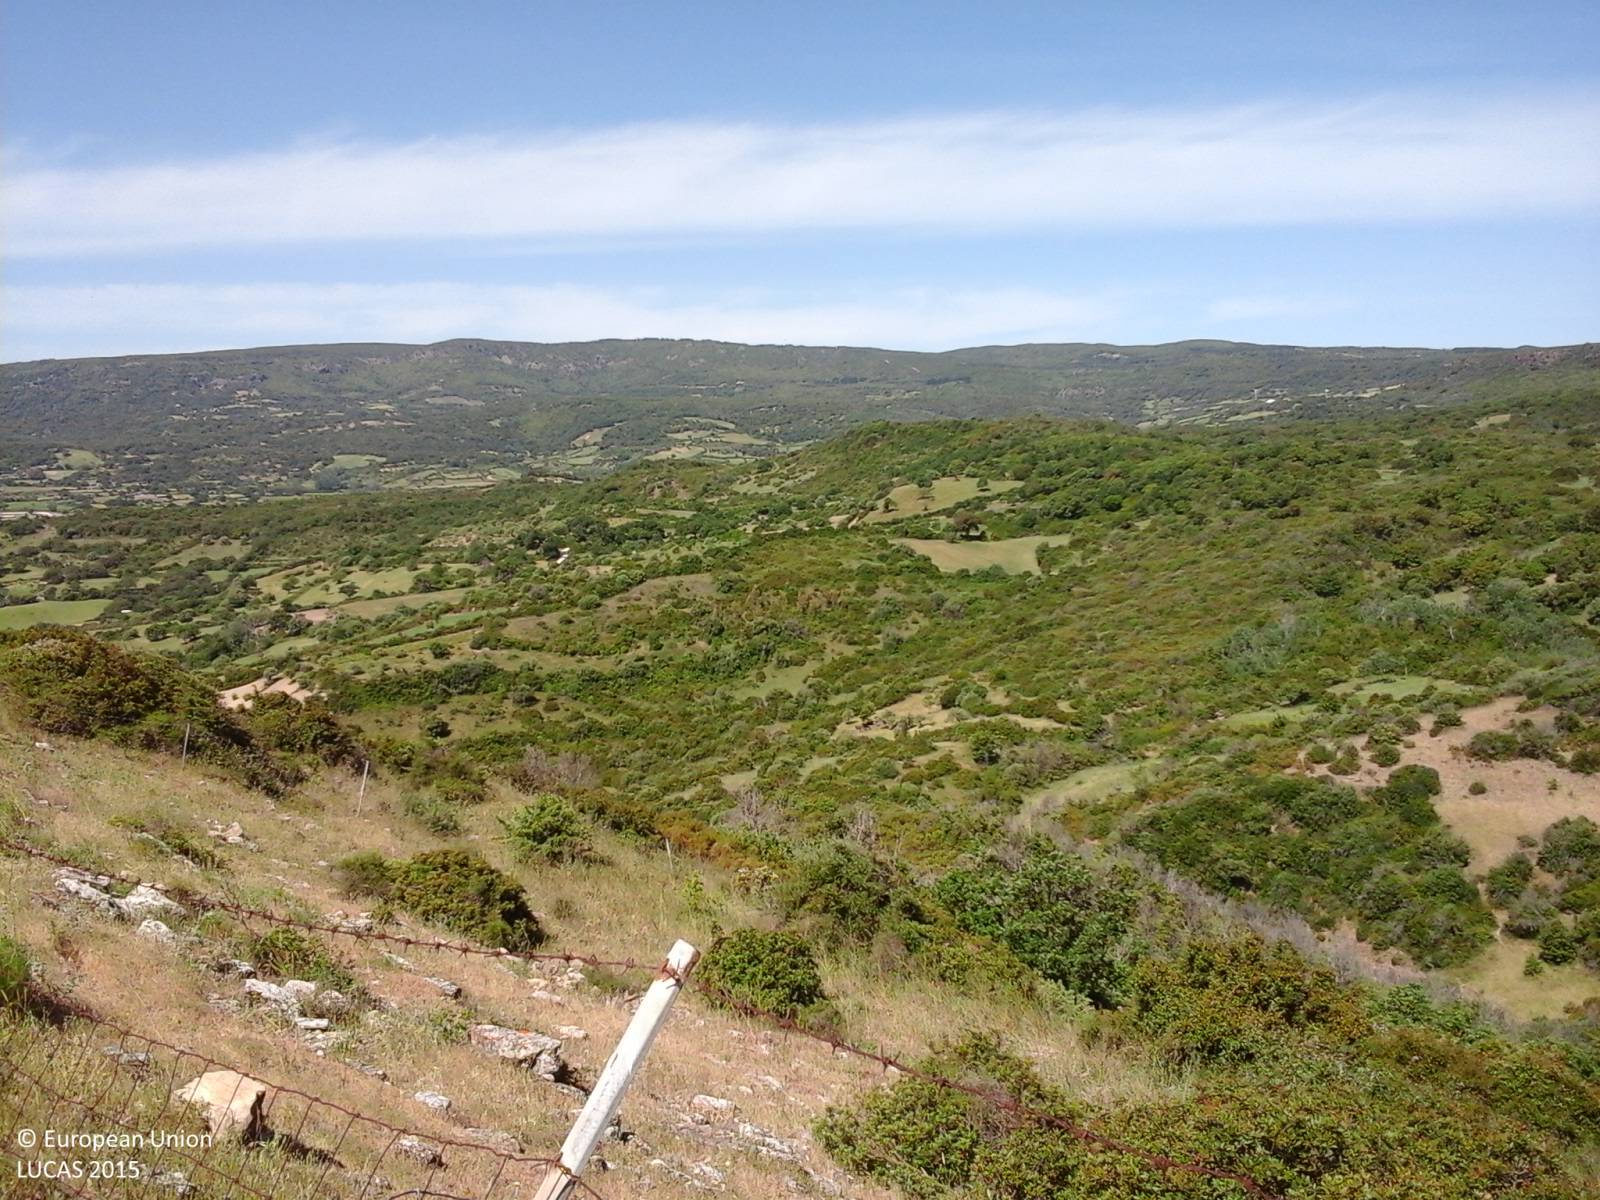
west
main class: Woodland
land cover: Broadleaved woodland
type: broadleaved evergreen forest
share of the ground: 50 - 75 %
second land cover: Grassland without tree/shrub cover
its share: 50 - 75 %
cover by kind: broadleaved forest trees 70 %, herbaceous plants 20 %, shrubs 10 %
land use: Forestry
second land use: Agriculture (excluding fallow land and kitchen gardens)
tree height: < 5 m
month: May
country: IT
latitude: 39.8076
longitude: 8.8269
